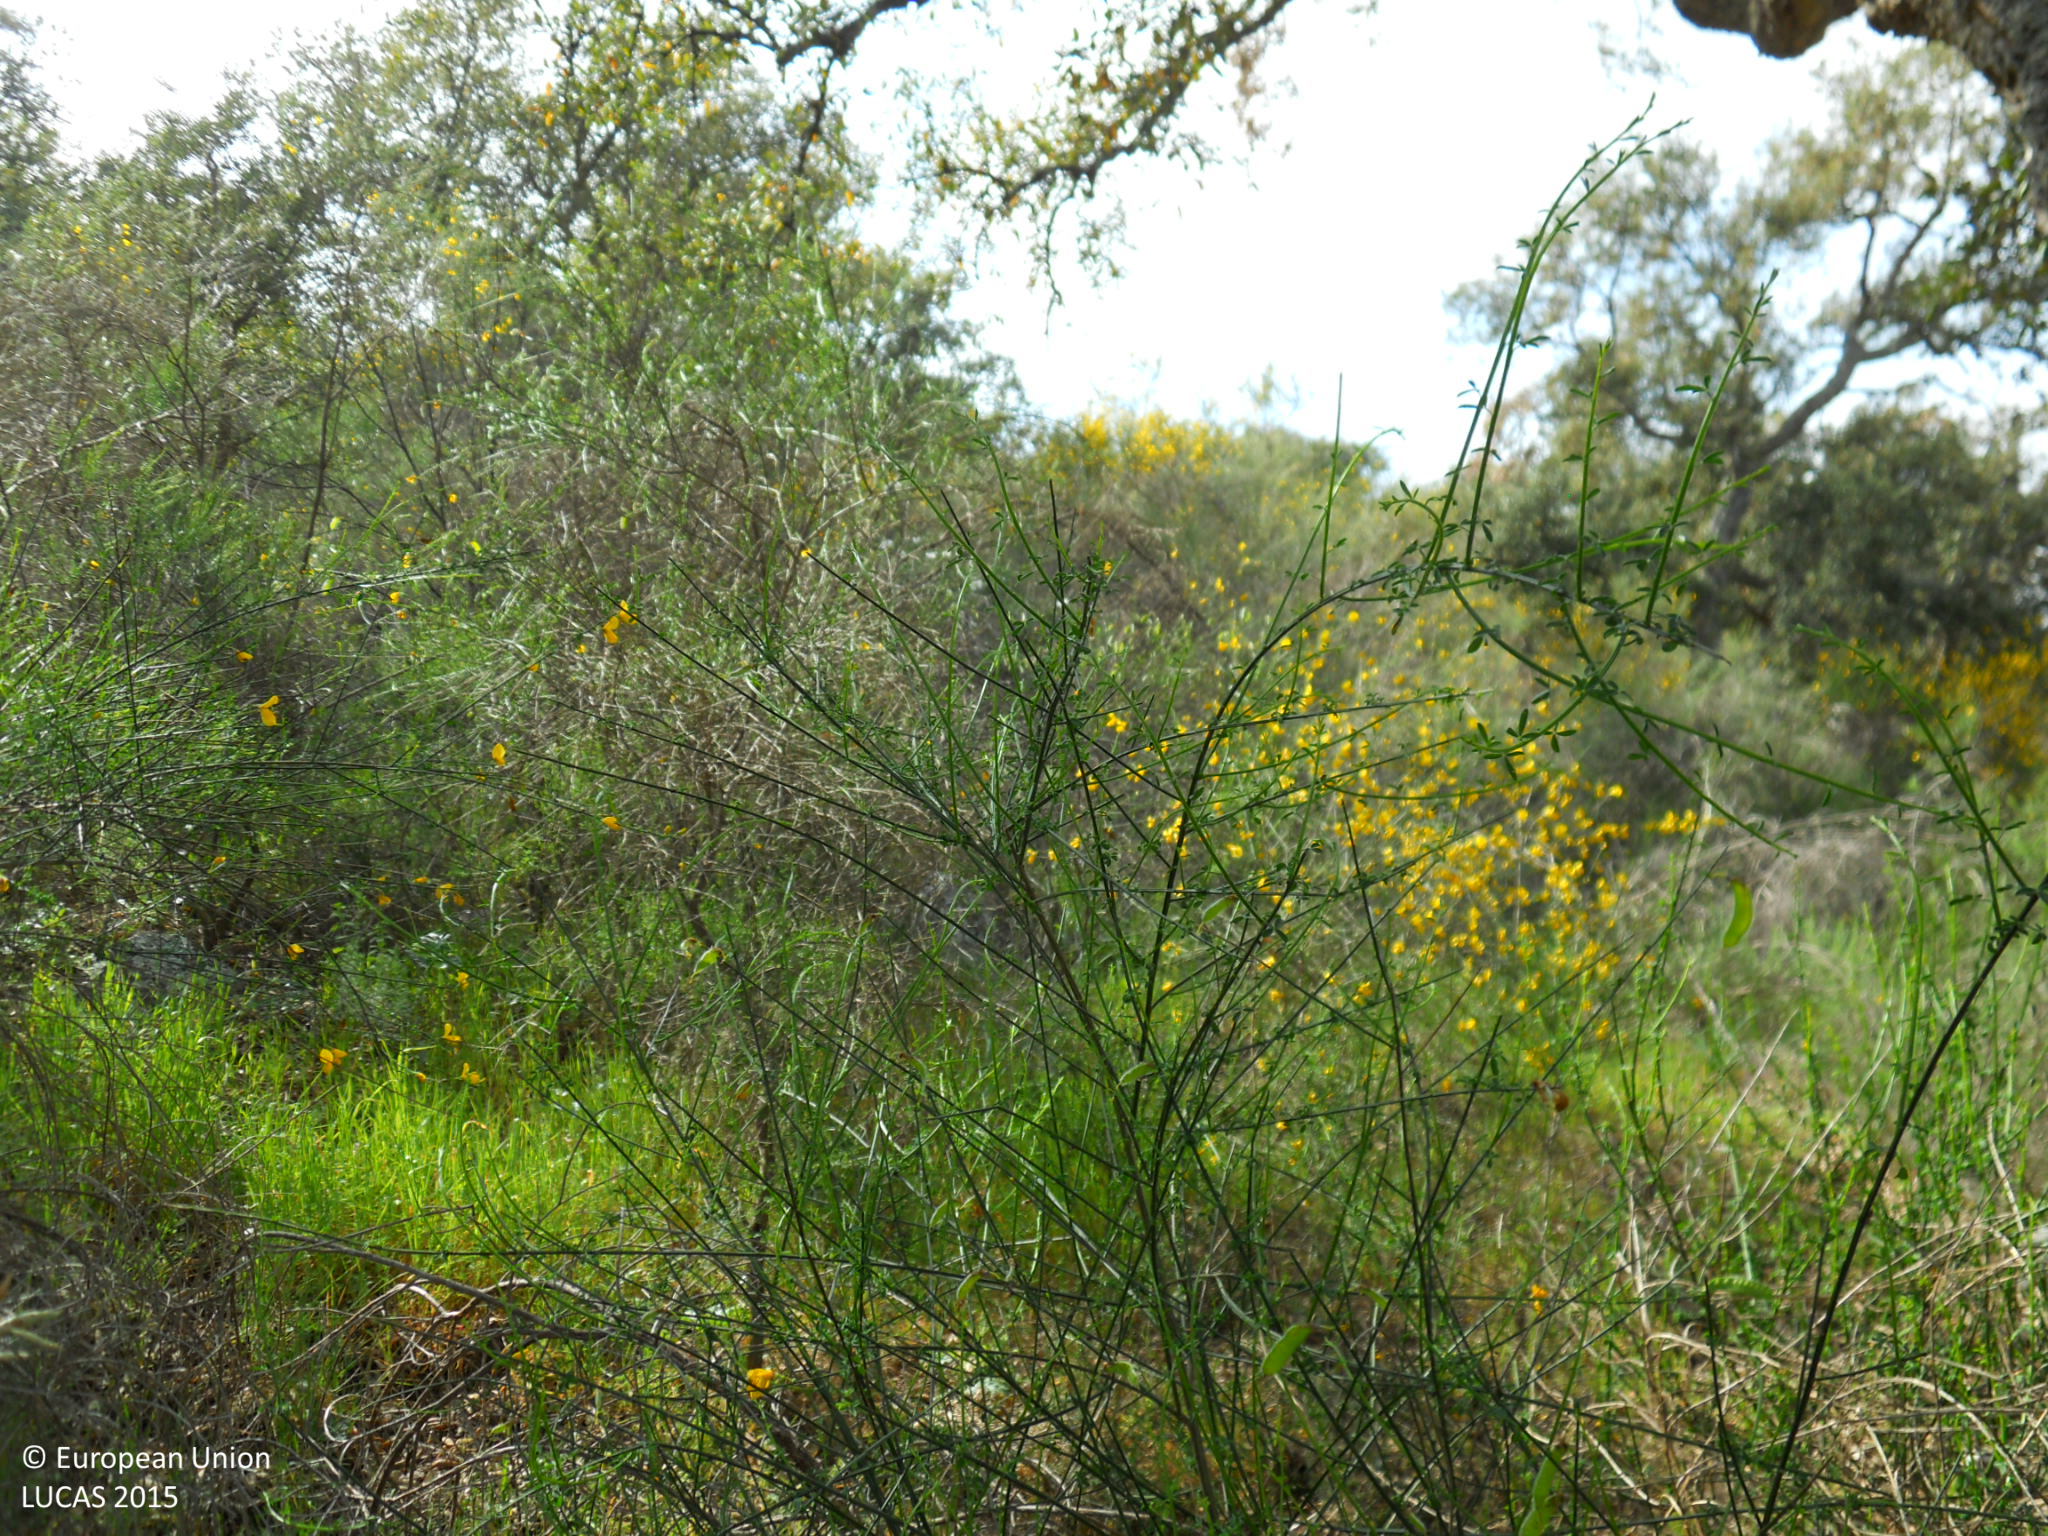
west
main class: Woodland
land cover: Broadleaved woodland
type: broadleaved evergreen forest
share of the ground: > 75 %
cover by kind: broadleaved forest trees 100 %
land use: Forestry
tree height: > 5 m
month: April
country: ES
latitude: 39.1900
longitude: -6.6125
